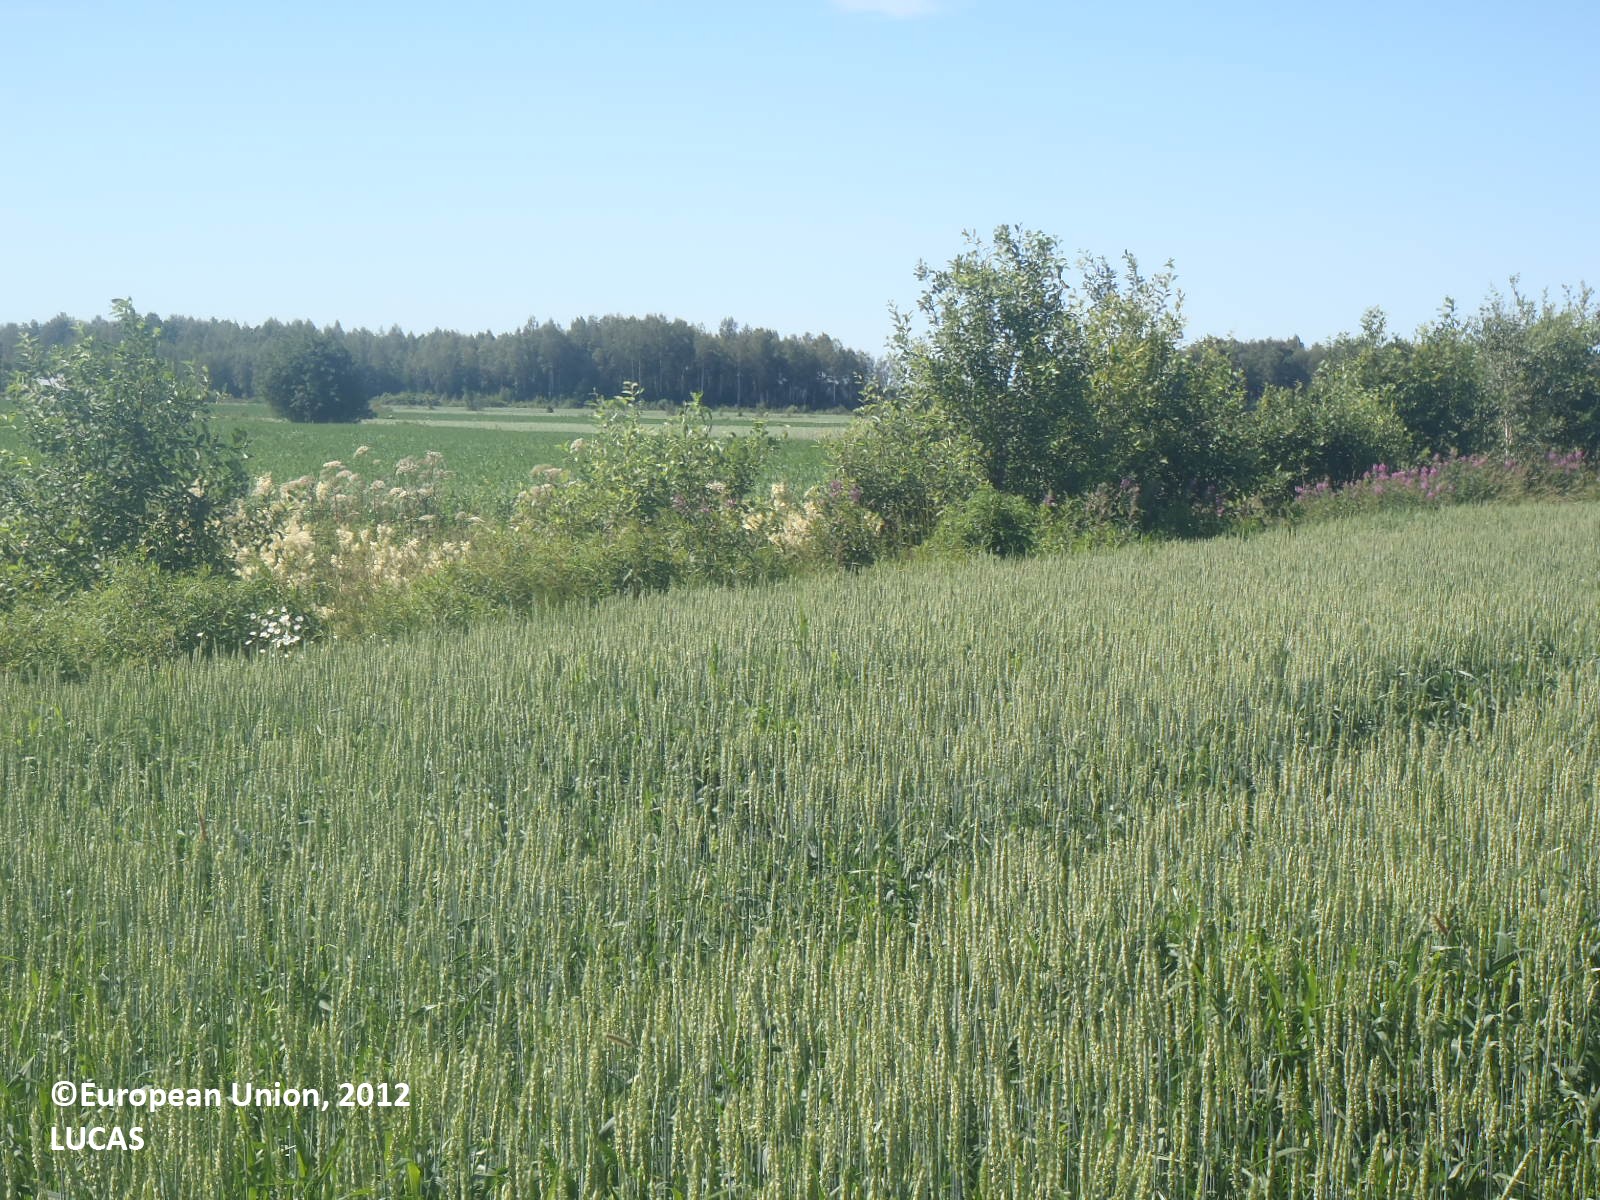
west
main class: Cropland
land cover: Common wheat
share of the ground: > 75 %
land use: Agriculture (excluding fallow land and kitchen gardens)
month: July
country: FI
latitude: 61.2032
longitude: 21.9496
